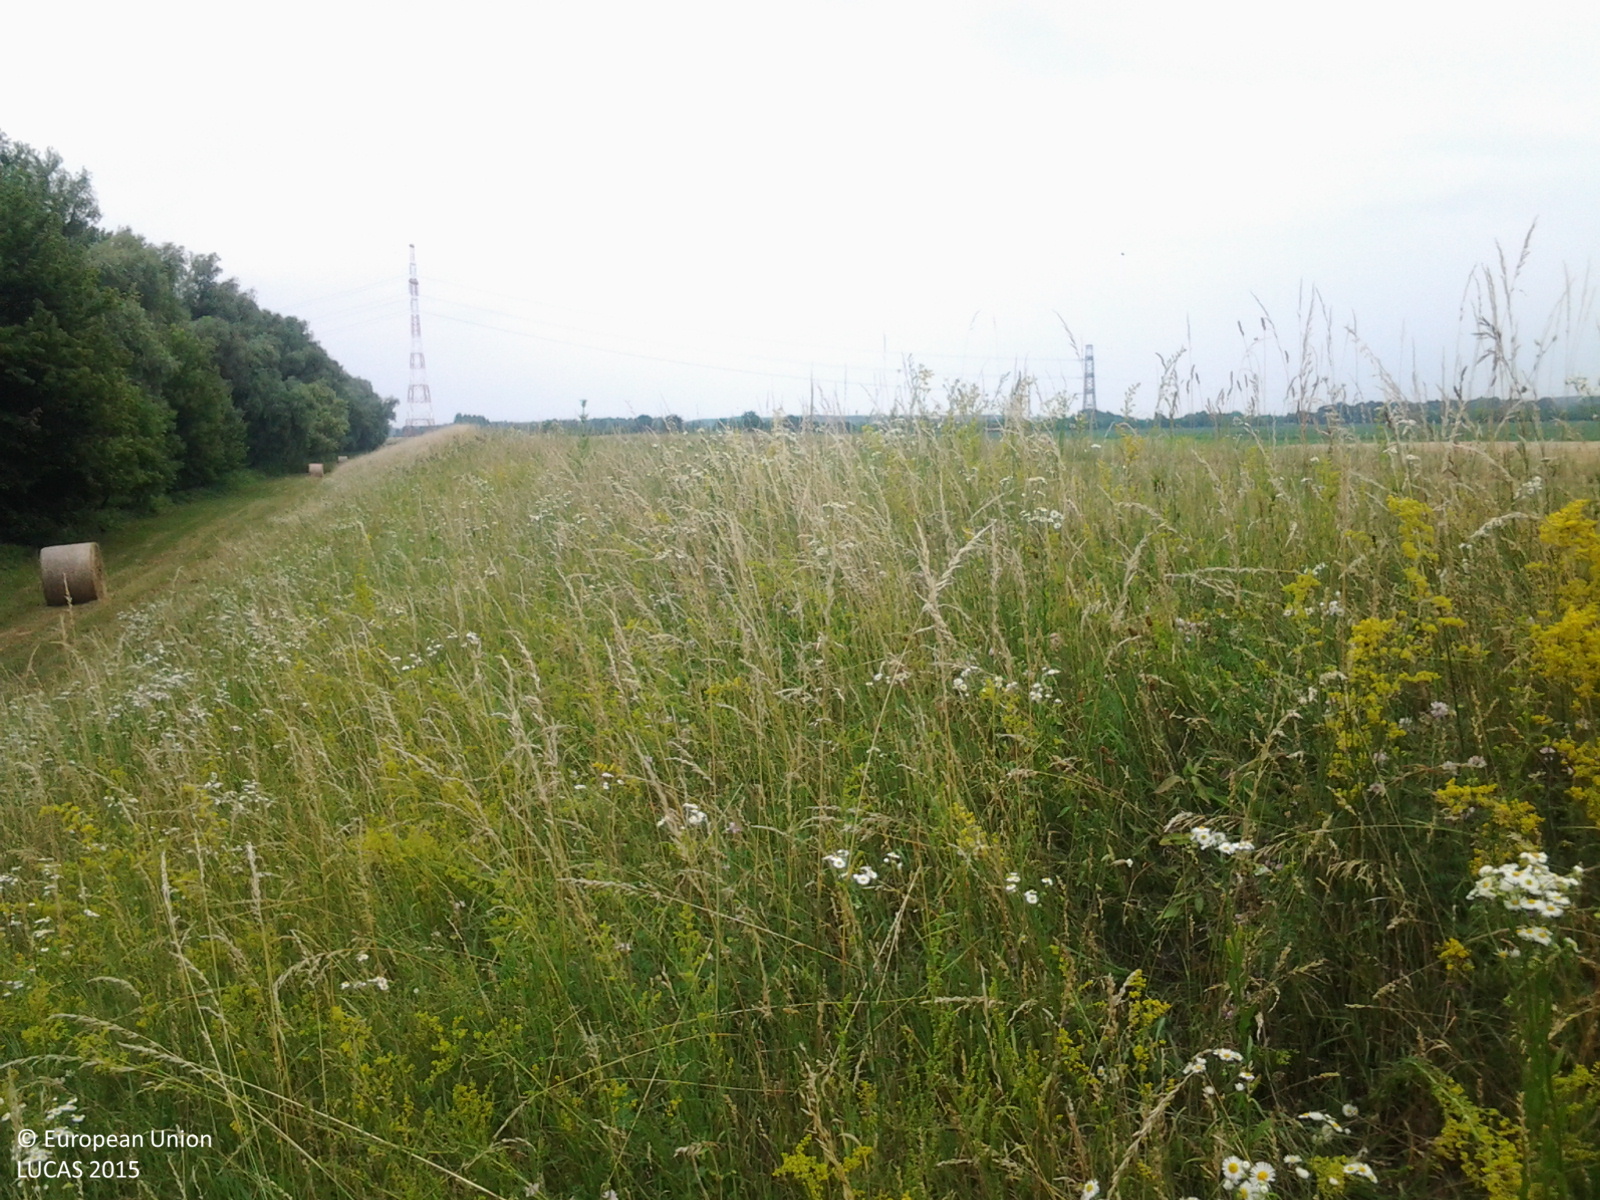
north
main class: Grassland
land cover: Grassland without tree/shrub cover
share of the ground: > 75 %
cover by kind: herbaceous plants 100 %
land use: Agriculture (excluding fallow land and kitchen gardens)
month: June
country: HU
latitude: 46.4659
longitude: 18.9332
